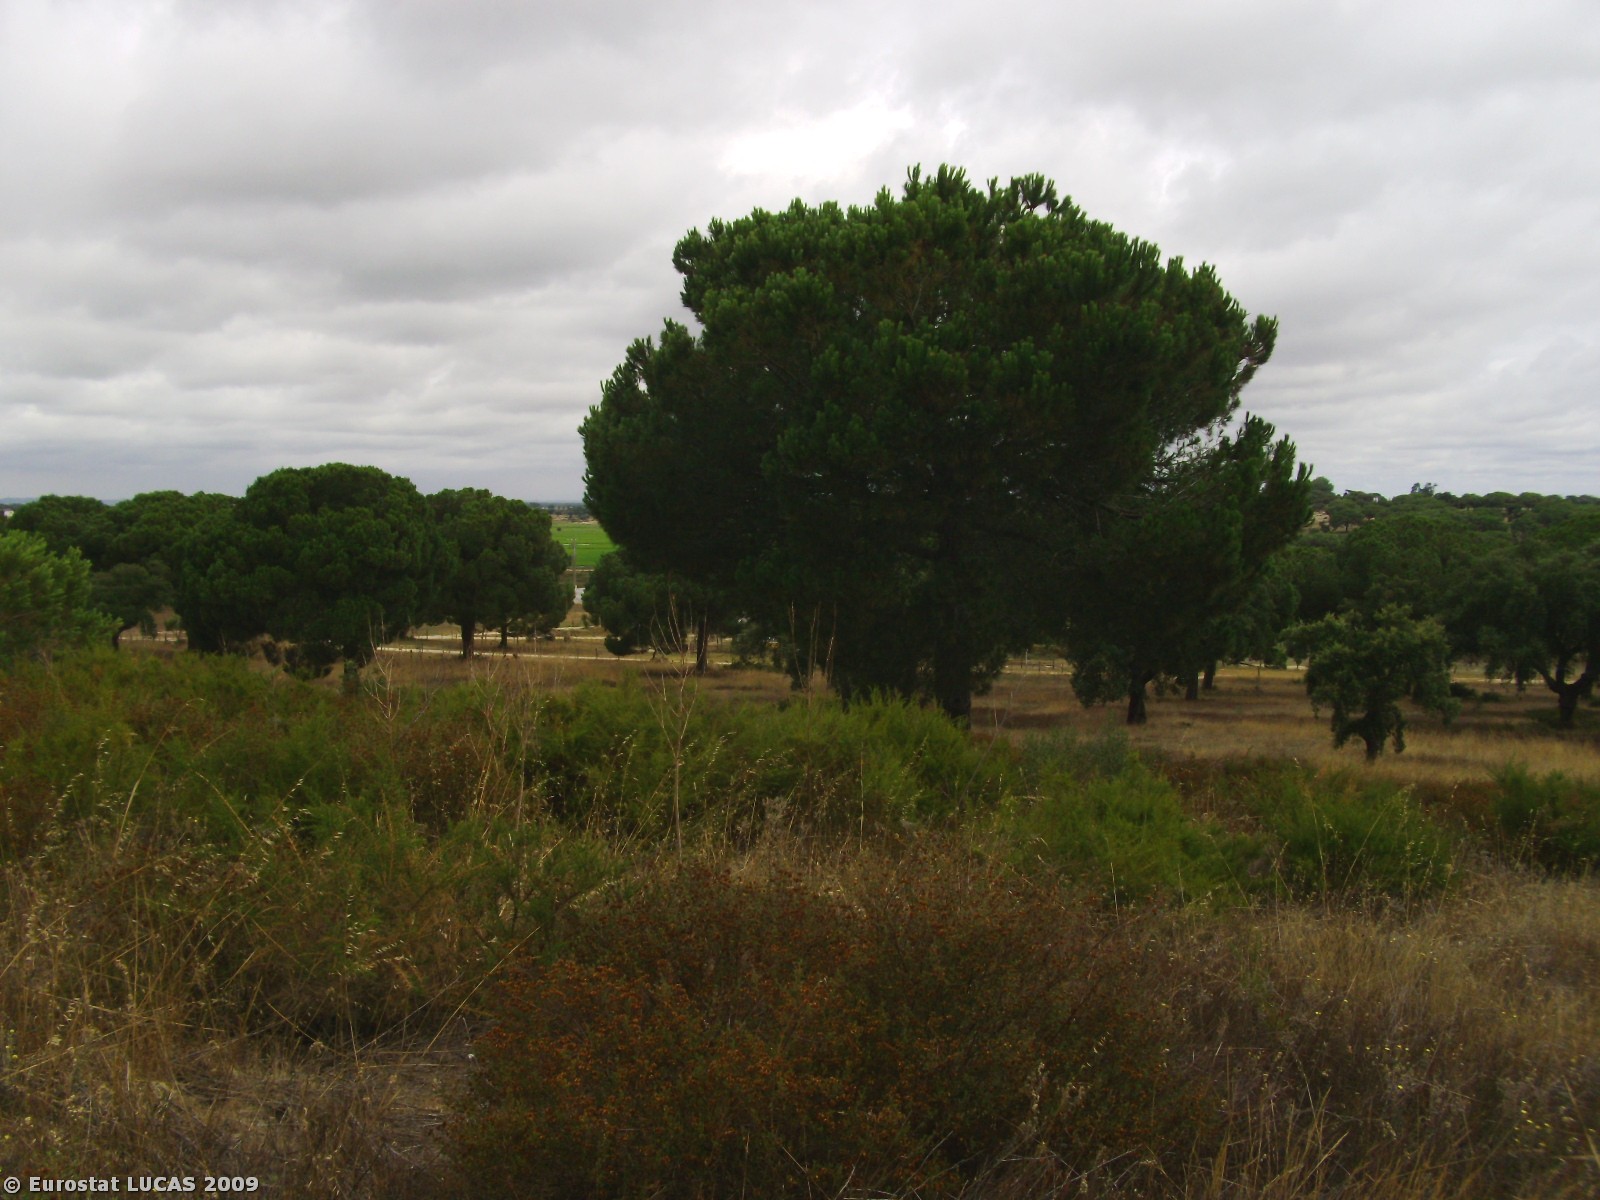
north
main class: Grassland
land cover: Spontaneously vegetated surfaces
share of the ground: > 75 %
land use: Fallow land
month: July
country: PT
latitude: 38.9373
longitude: -8.7698
